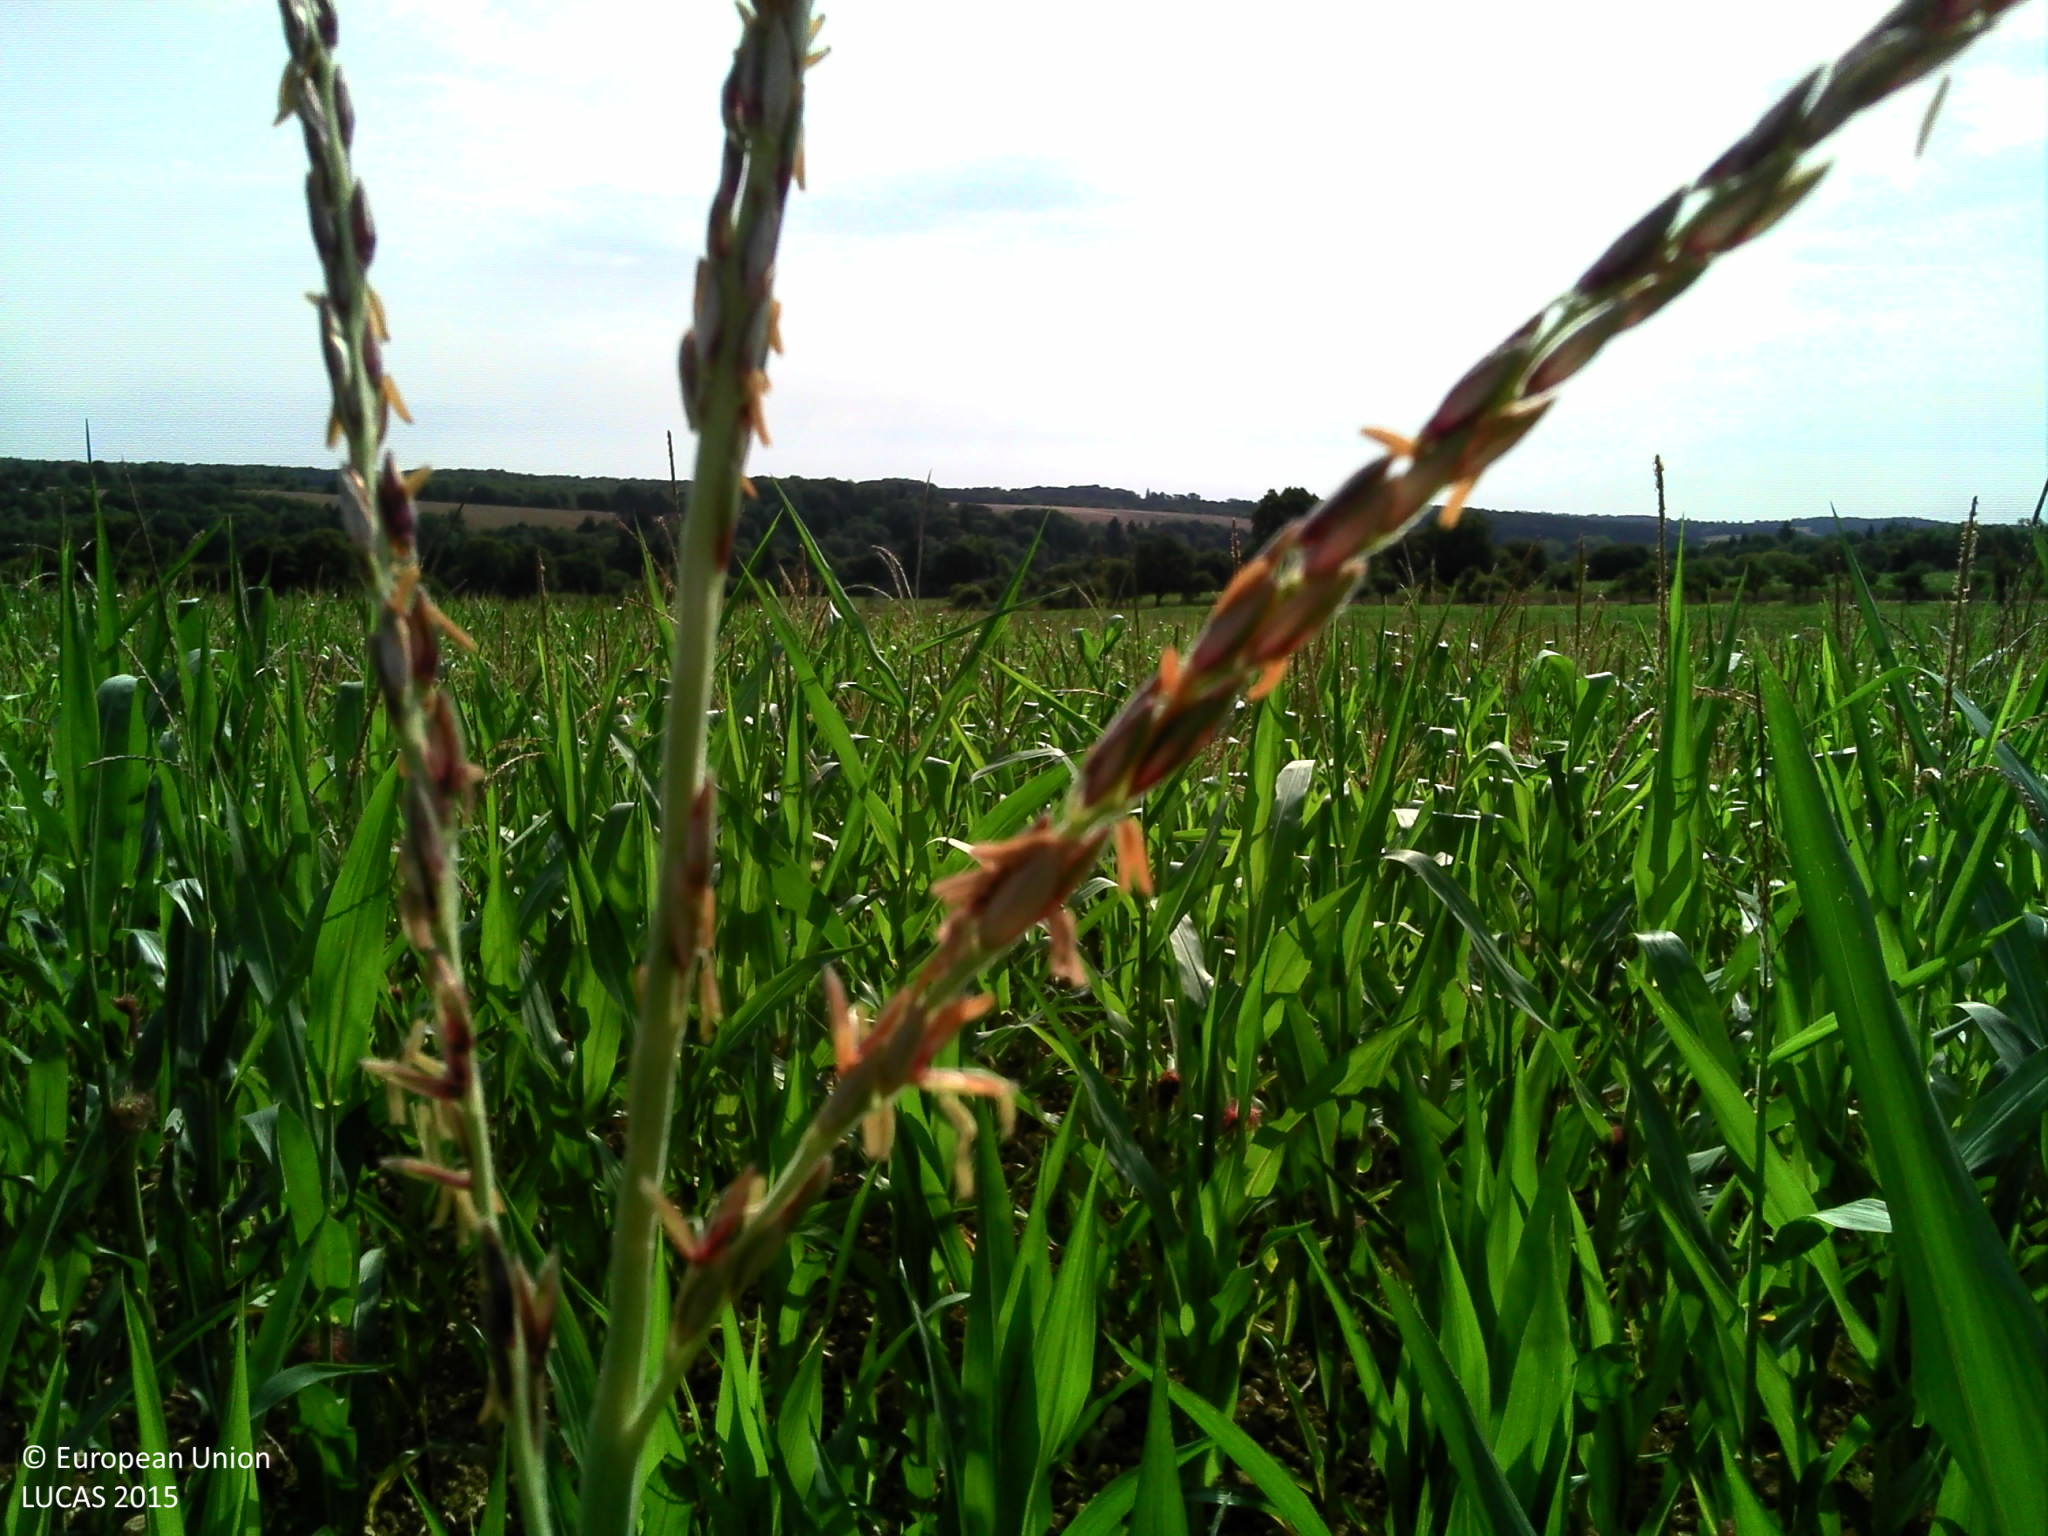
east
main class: Cropland
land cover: Maize
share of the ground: > 75 %
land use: Agriculture (excluding fallow land and kitchen gardens)
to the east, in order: Maize
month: August
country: FR
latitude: 47.7039
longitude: 3.1578
